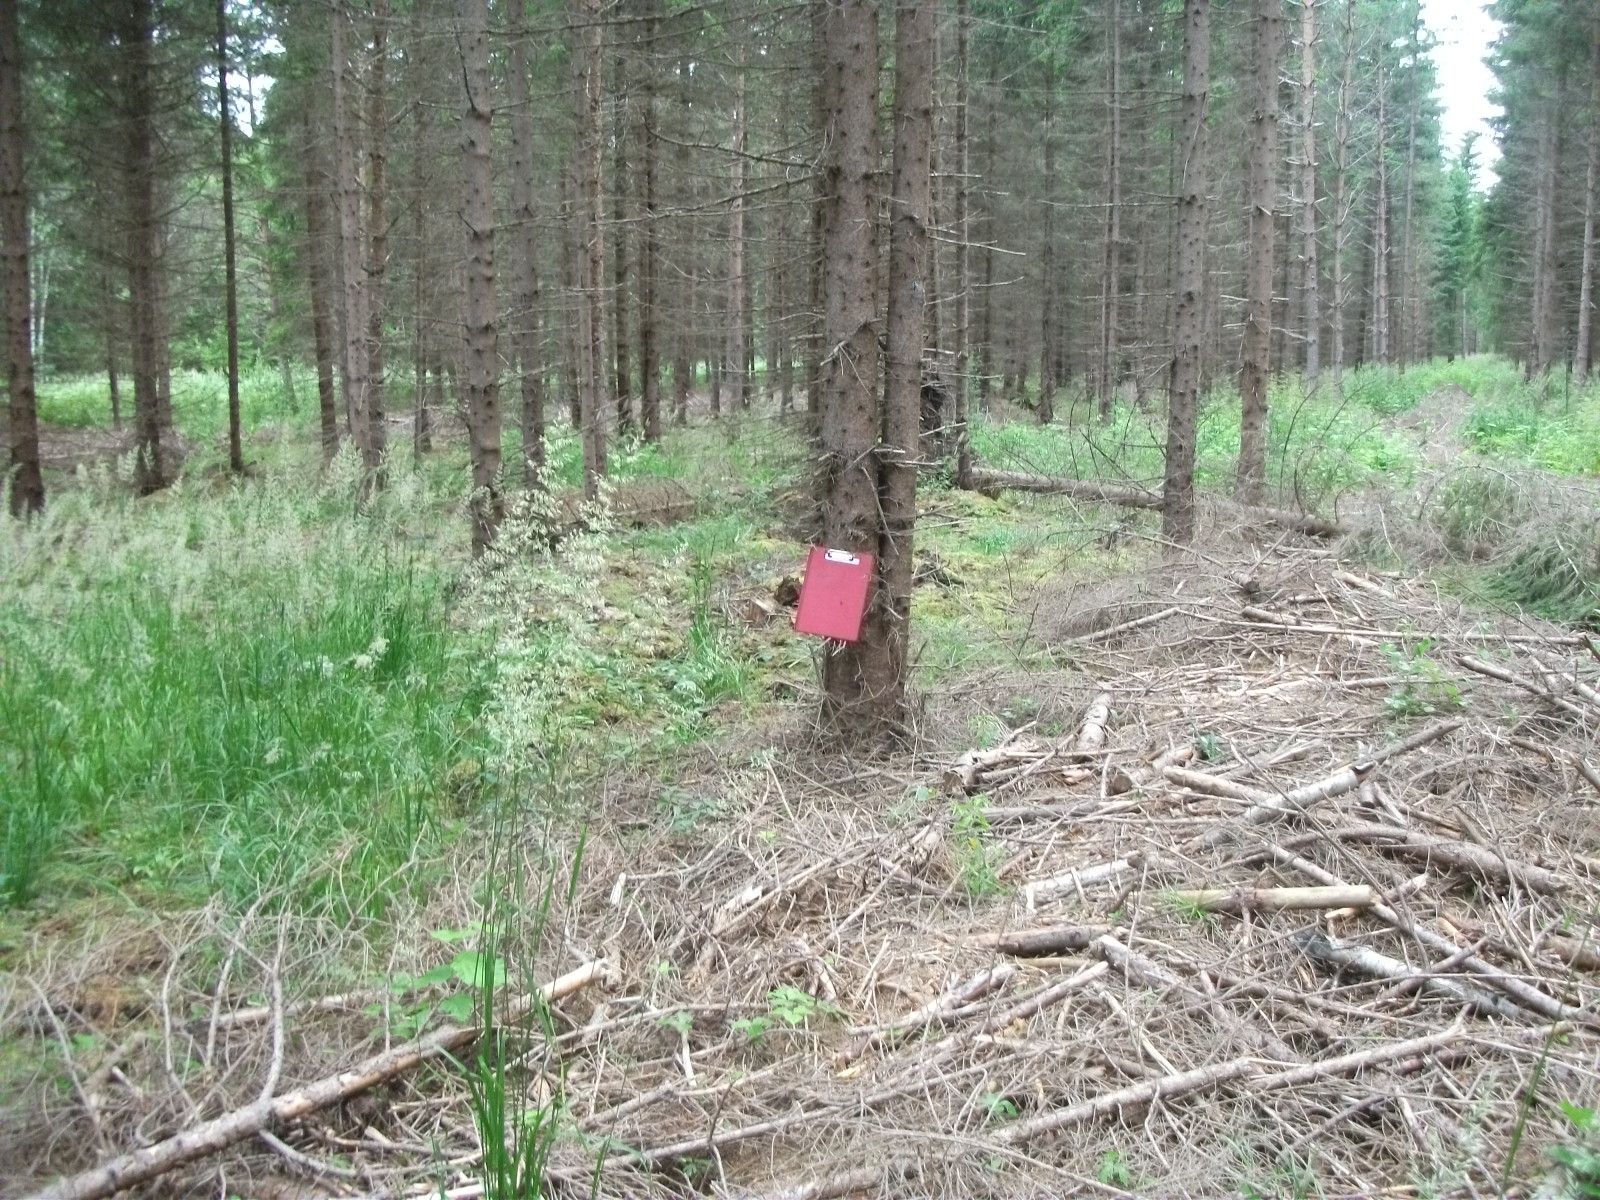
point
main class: Woodland
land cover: Spruce dominated coniferous woodland
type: hemiboreal forest and nemoral coniferous forest and mixed broadleaved-coniferous forest
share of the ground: > 75 %
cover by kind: coniferous forest trees 75 %, herbaceous plants 15 %, lichens and mosses 10 %
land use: Forestry
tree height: > 5 m
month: July
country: LV
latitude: 57.1915
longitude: 26.4764
